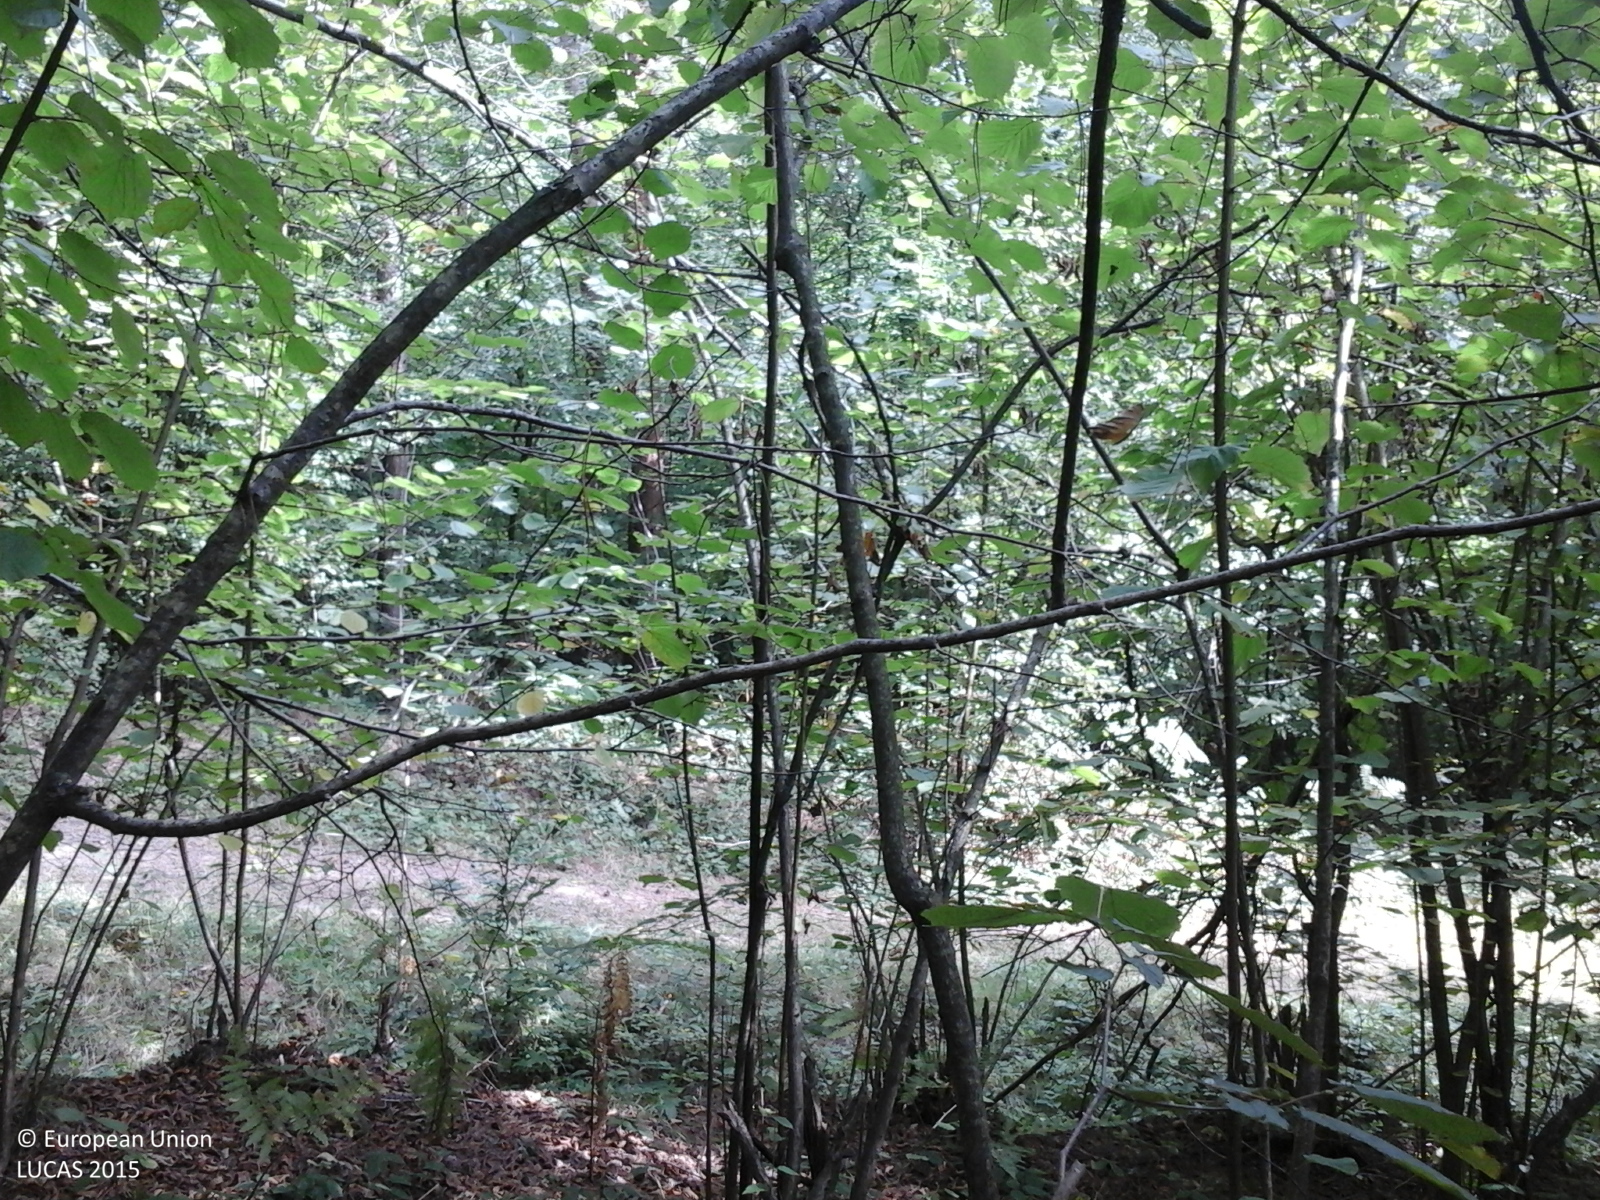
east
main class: Woodland
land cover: Pine dominated mixed woodland
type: hemiboreal forest and nemoral coniferous forest and mixed broadleaved-coniferous forest
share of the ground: > 75 %
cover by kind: coniferous forest trees 75 %, broadleaved forest trees 25 %
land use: Forestry
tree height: > 5 m
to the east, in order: Pine dominated mixed woodland; Tracks; Pine dominated mixed woodland; Grassland without tree/shrub cover; Broadleaved woodland; Other fruit trees and berries; Pine dominated mixed woodland
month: September
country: RO
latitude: 47.4462
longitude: 24.0484
